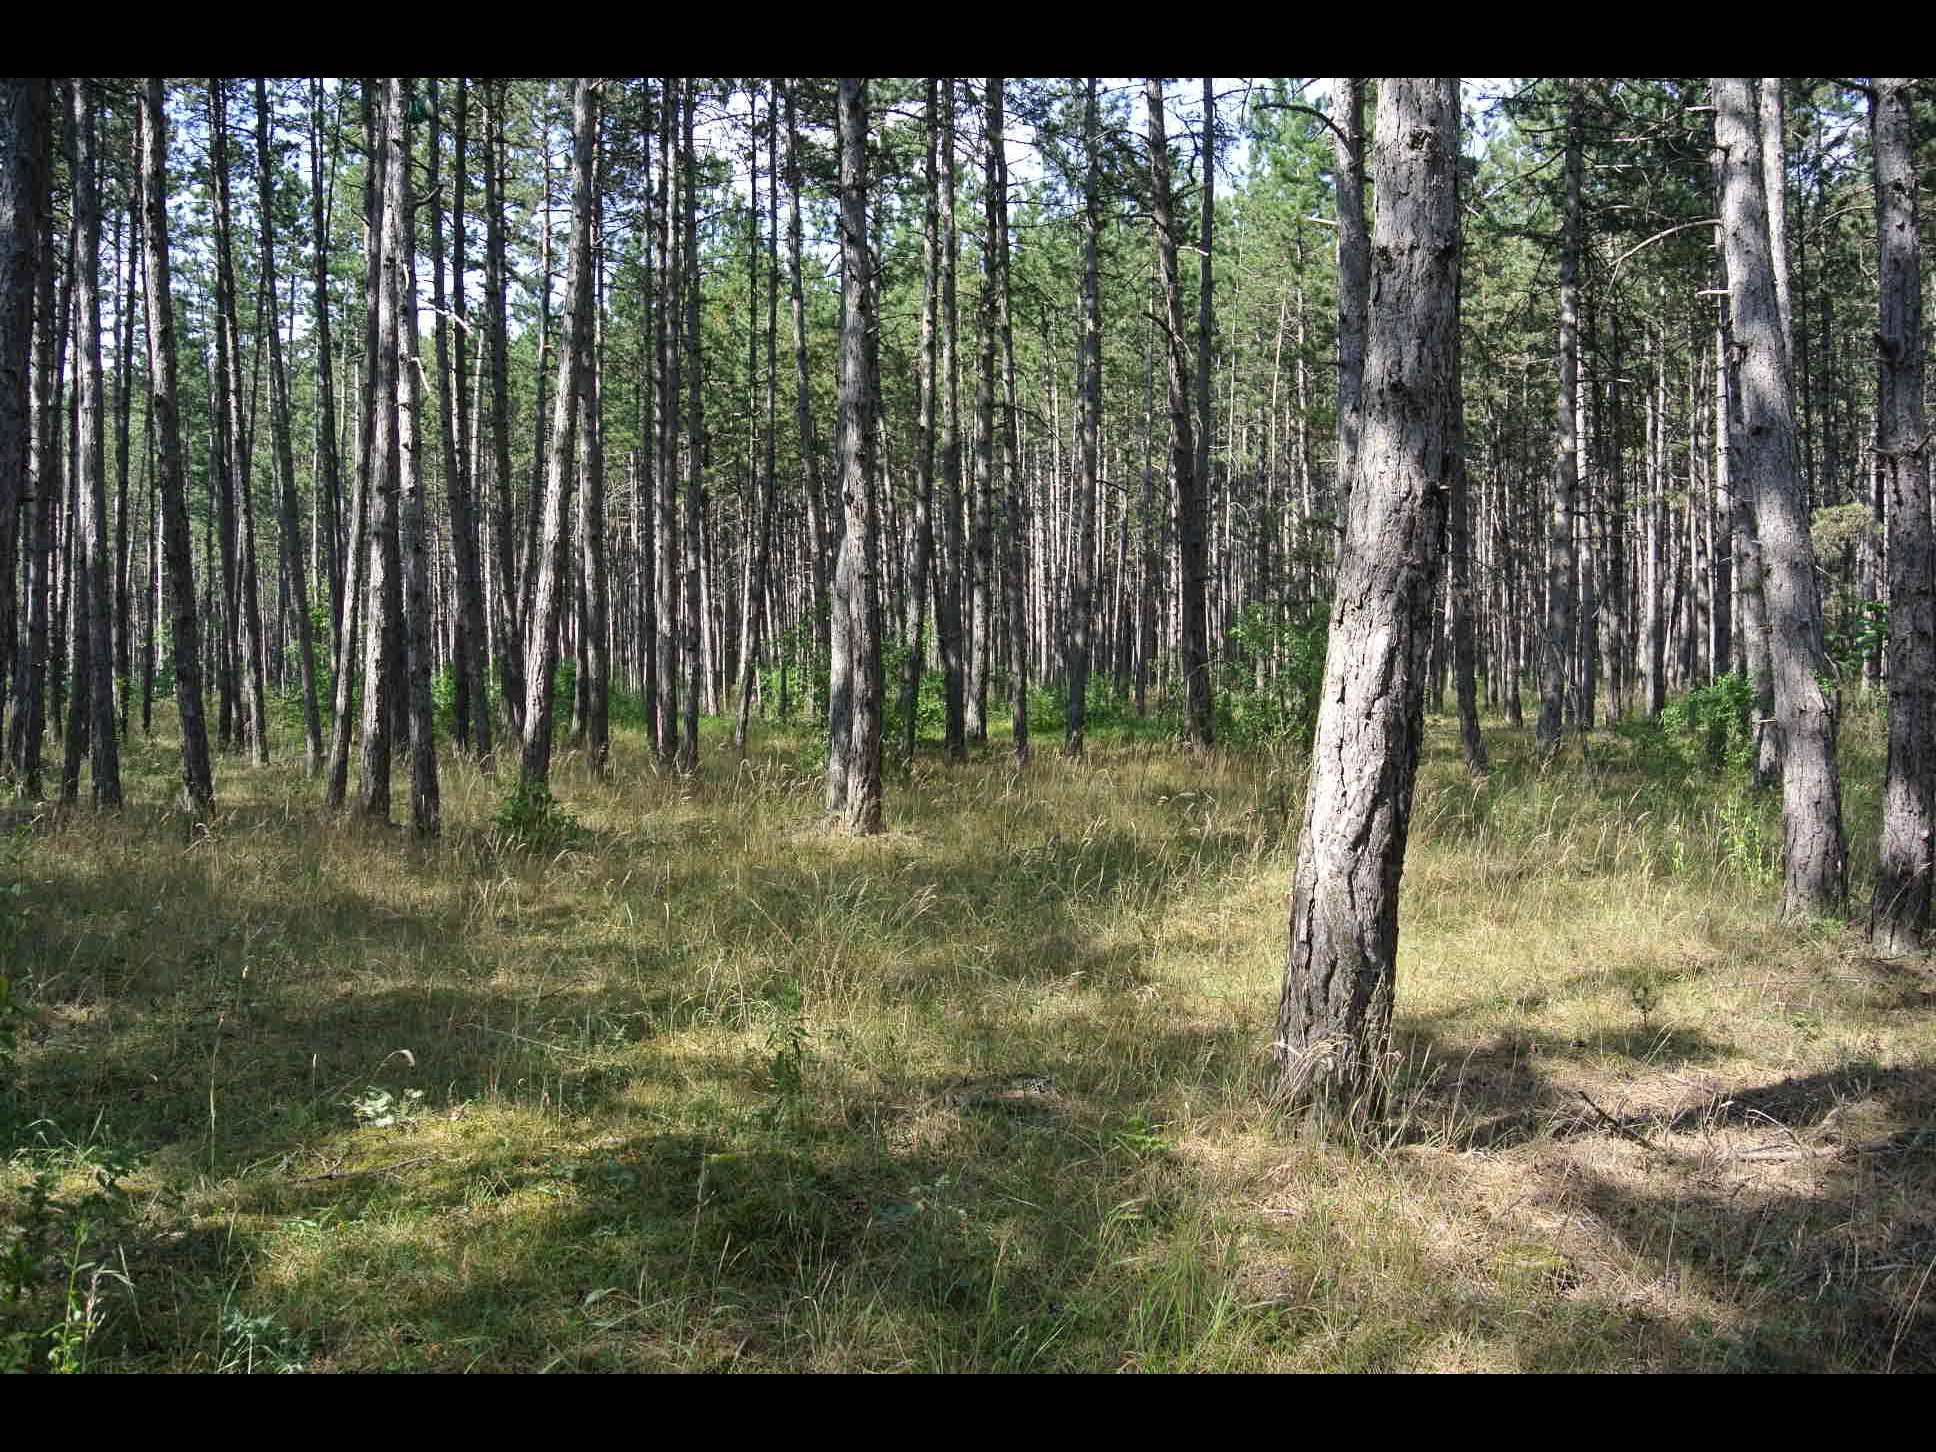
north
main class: Woodland
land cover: Pine dominated coniferous woodland
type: alpine coniferous forest
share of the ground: > 75 %
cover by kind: coniferous forest trees 90 %, herbaceous plants 10 %
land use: Forestry
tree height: > 5 m
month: July
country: AT
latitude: 47.7793
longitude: 16.1826
